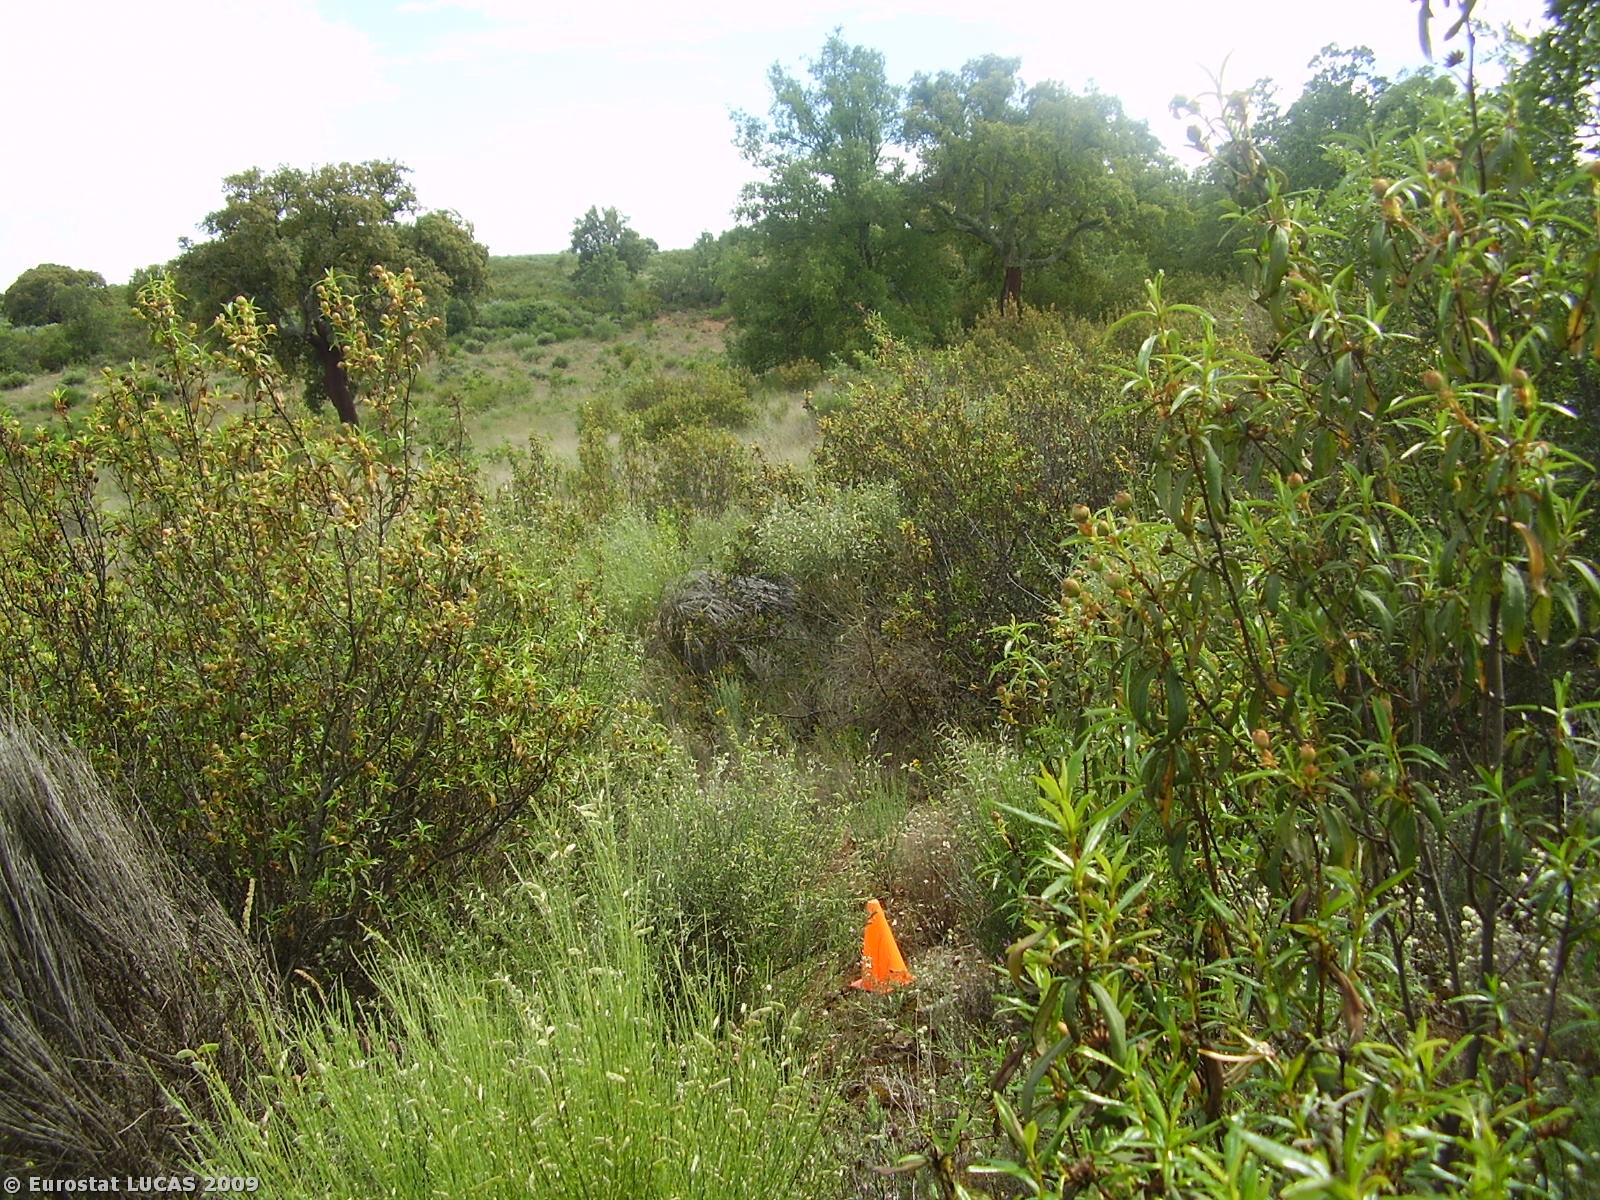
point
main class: Shrubland
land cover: Shrubland with sparse tree cover
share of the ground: > 75 %
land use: Nature reserves
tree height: > 5 m
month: June
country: PT
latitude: 41.5460
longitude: -6.8344
